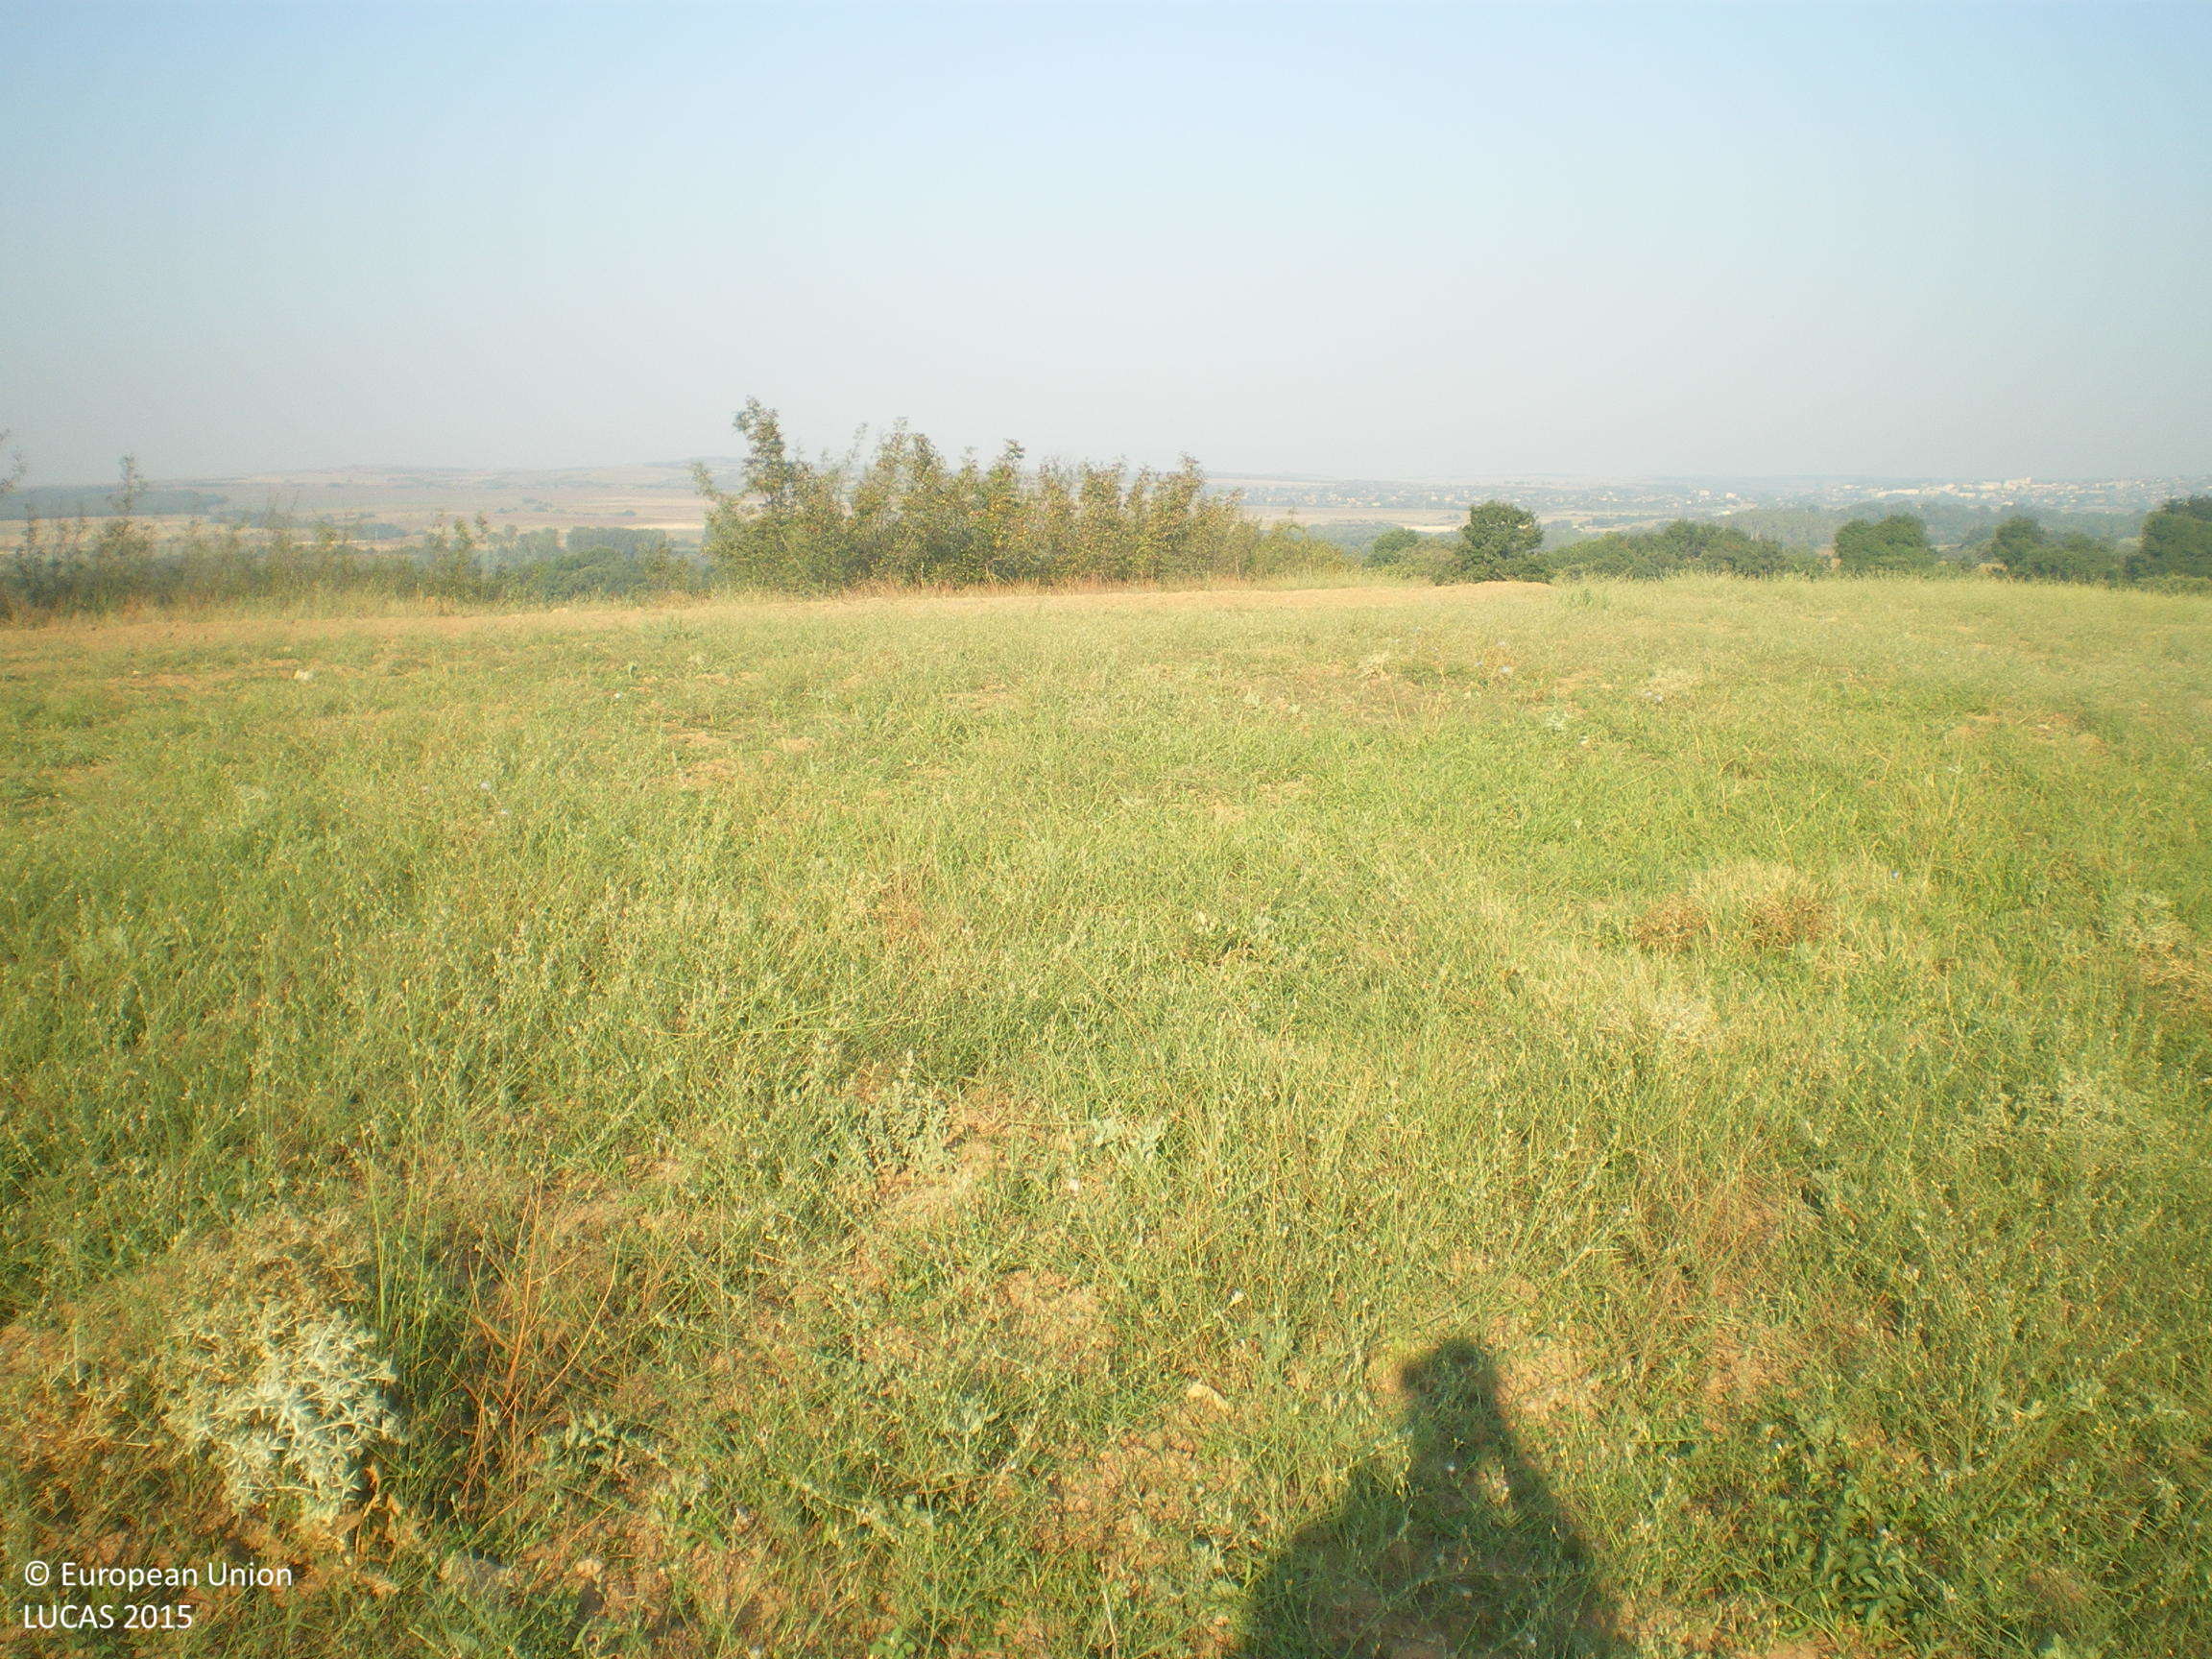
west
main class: Grassland
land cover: Grassland without tree/shrub cover
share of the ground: > 75 %
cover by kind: herbaceous plants 100 %
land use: Agriculture (excluding fallow land and kitchen gardens)
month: August
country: BG
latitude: 42.0128
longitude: 25.9031
